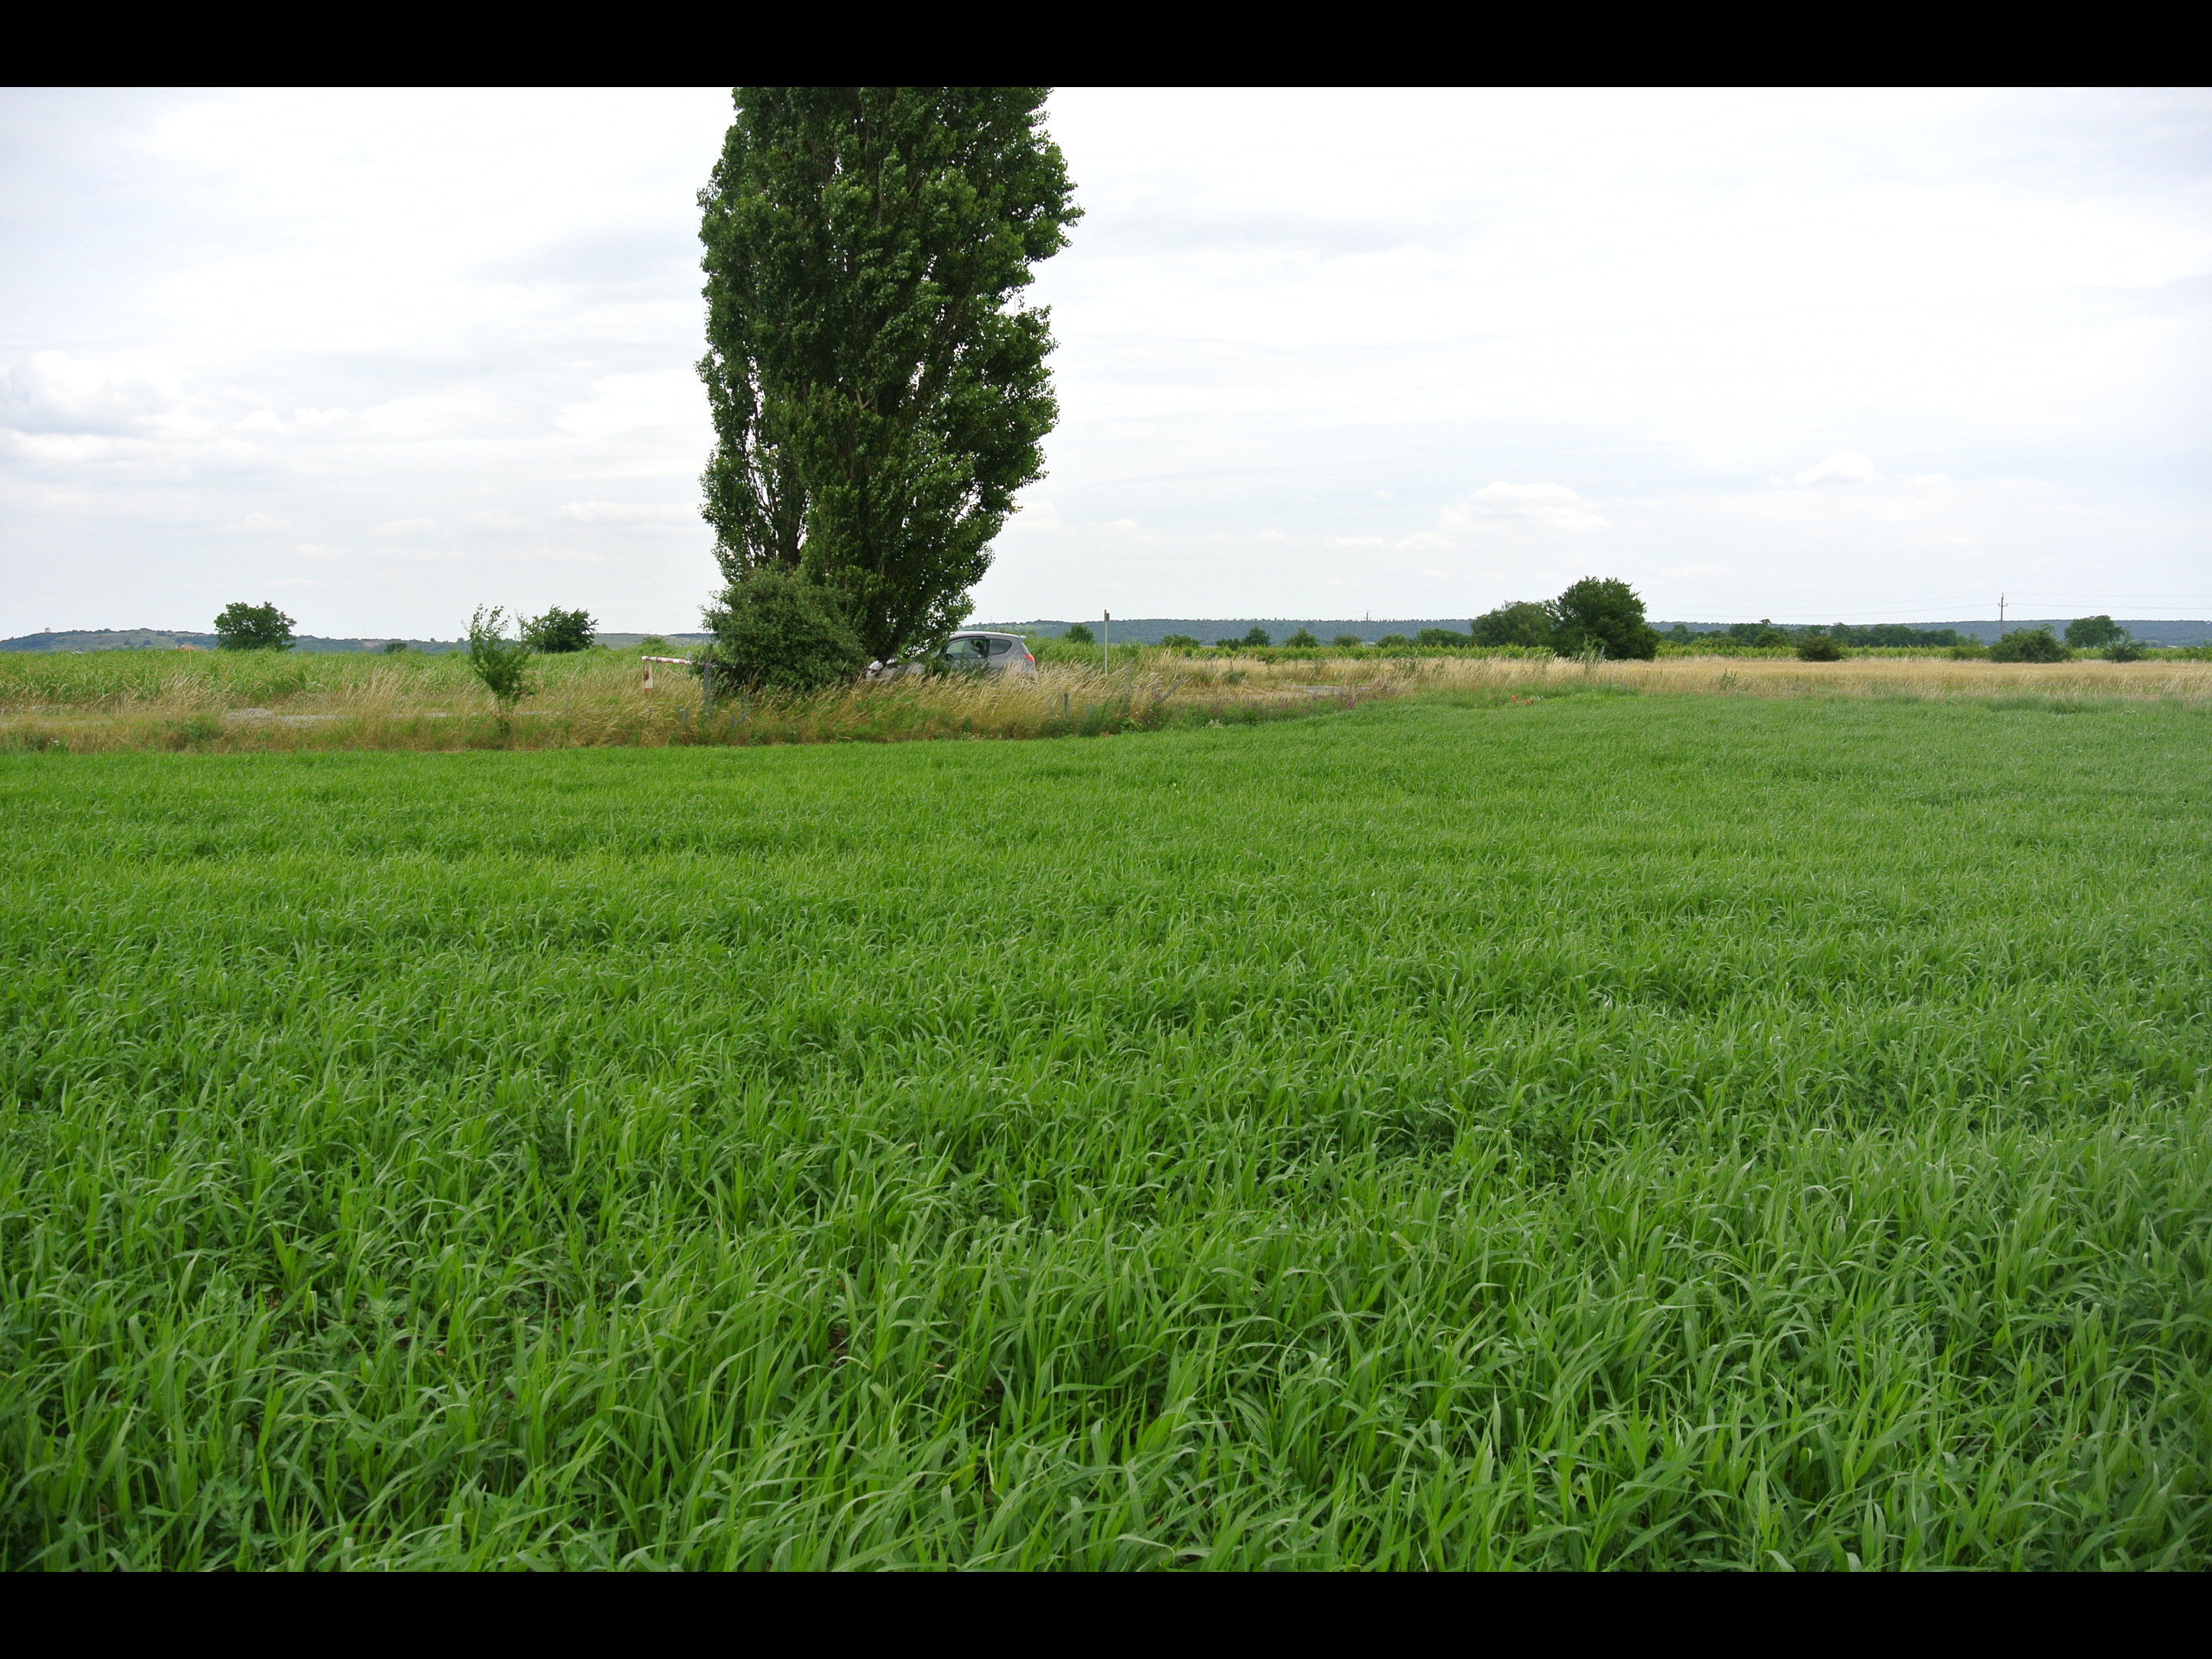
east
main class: Cropland
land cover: Common wheat
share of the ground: > 75 %
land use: Agriculture (excluding fallow land and kitchen gardens)
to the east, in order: Common wheat; Grassland with sparse tree/shrub cover; Tracks; Grassland without tree/shrub cover; Paved roads, cycling and walking lanes; Dry pulses; Vineyards; Grassland without tree/shrub cover; Common wheat; Dry pulses
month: June
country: AT
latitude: 47.7918
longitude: 16.5860
